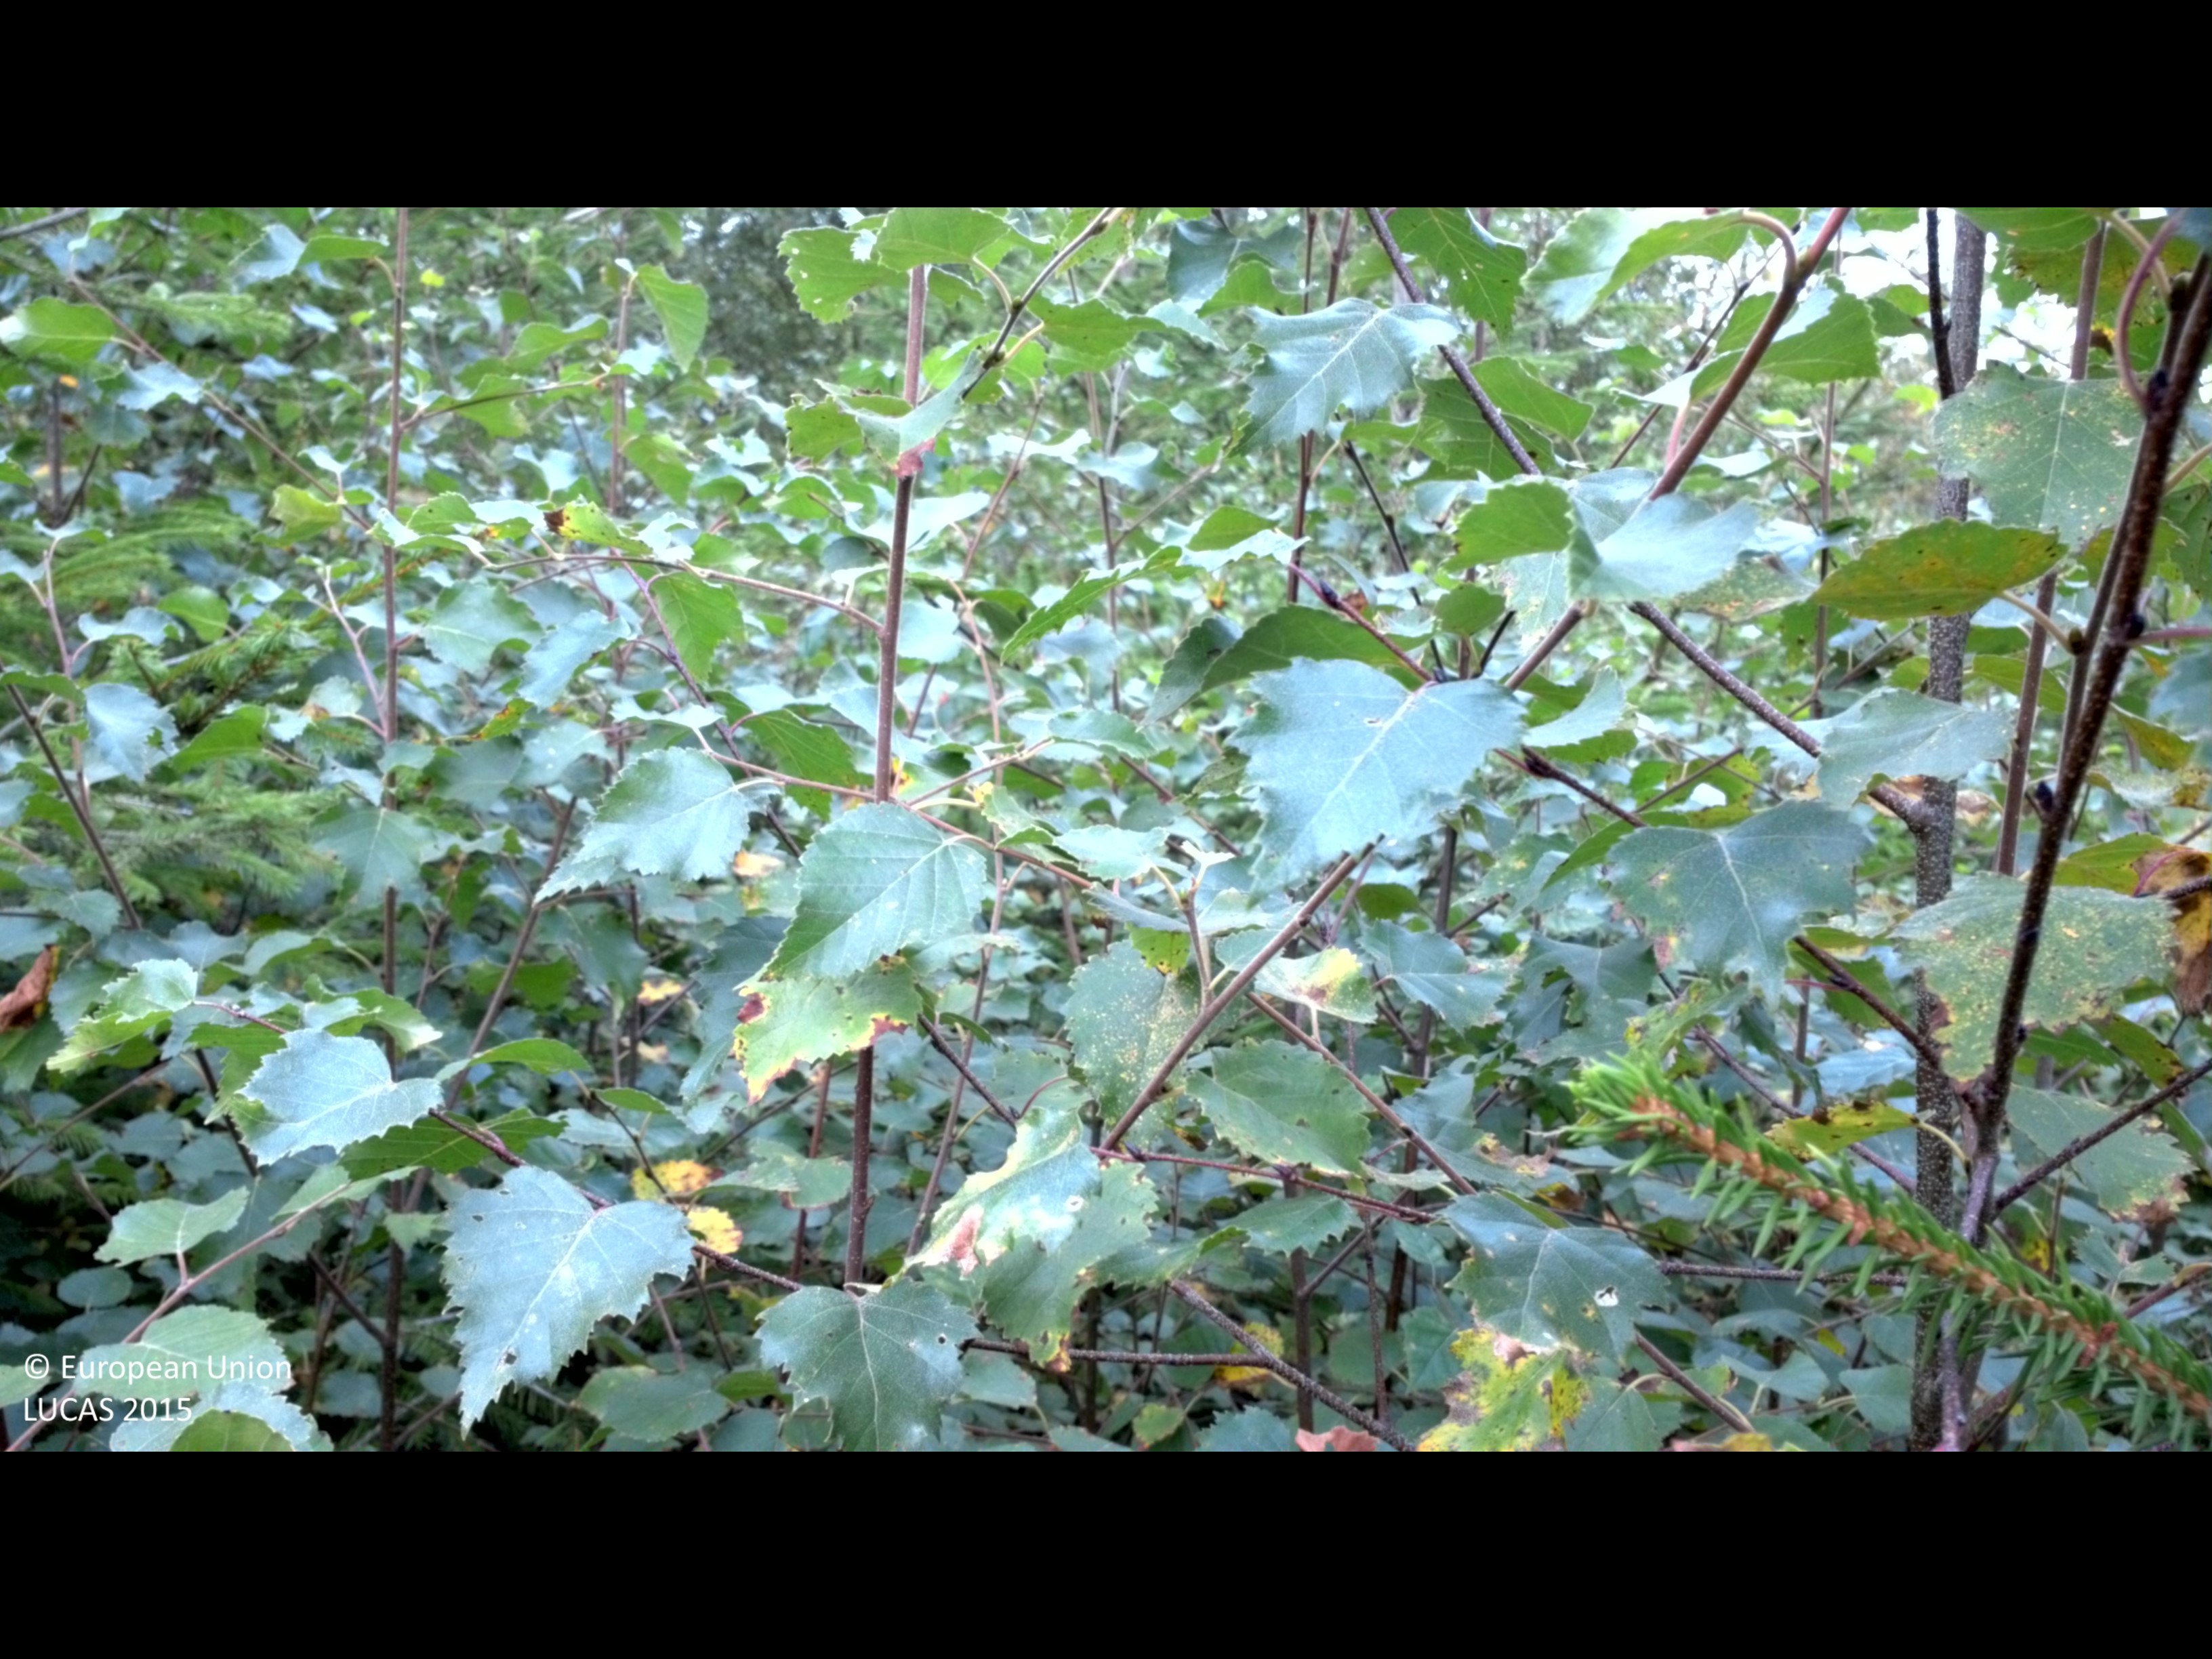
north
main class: Woodland
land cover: Spruce dominated mixed woodland
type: boreal forest
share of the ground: > 75 %
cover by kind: broadleaved forest trees 55 %, coniferous forest trees 35 %, shrubs 5 %, herbaceous plants 5 %
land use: Forestry
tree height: < 5 m
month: September
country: SE
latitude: 56.7616
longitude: 13.1211
